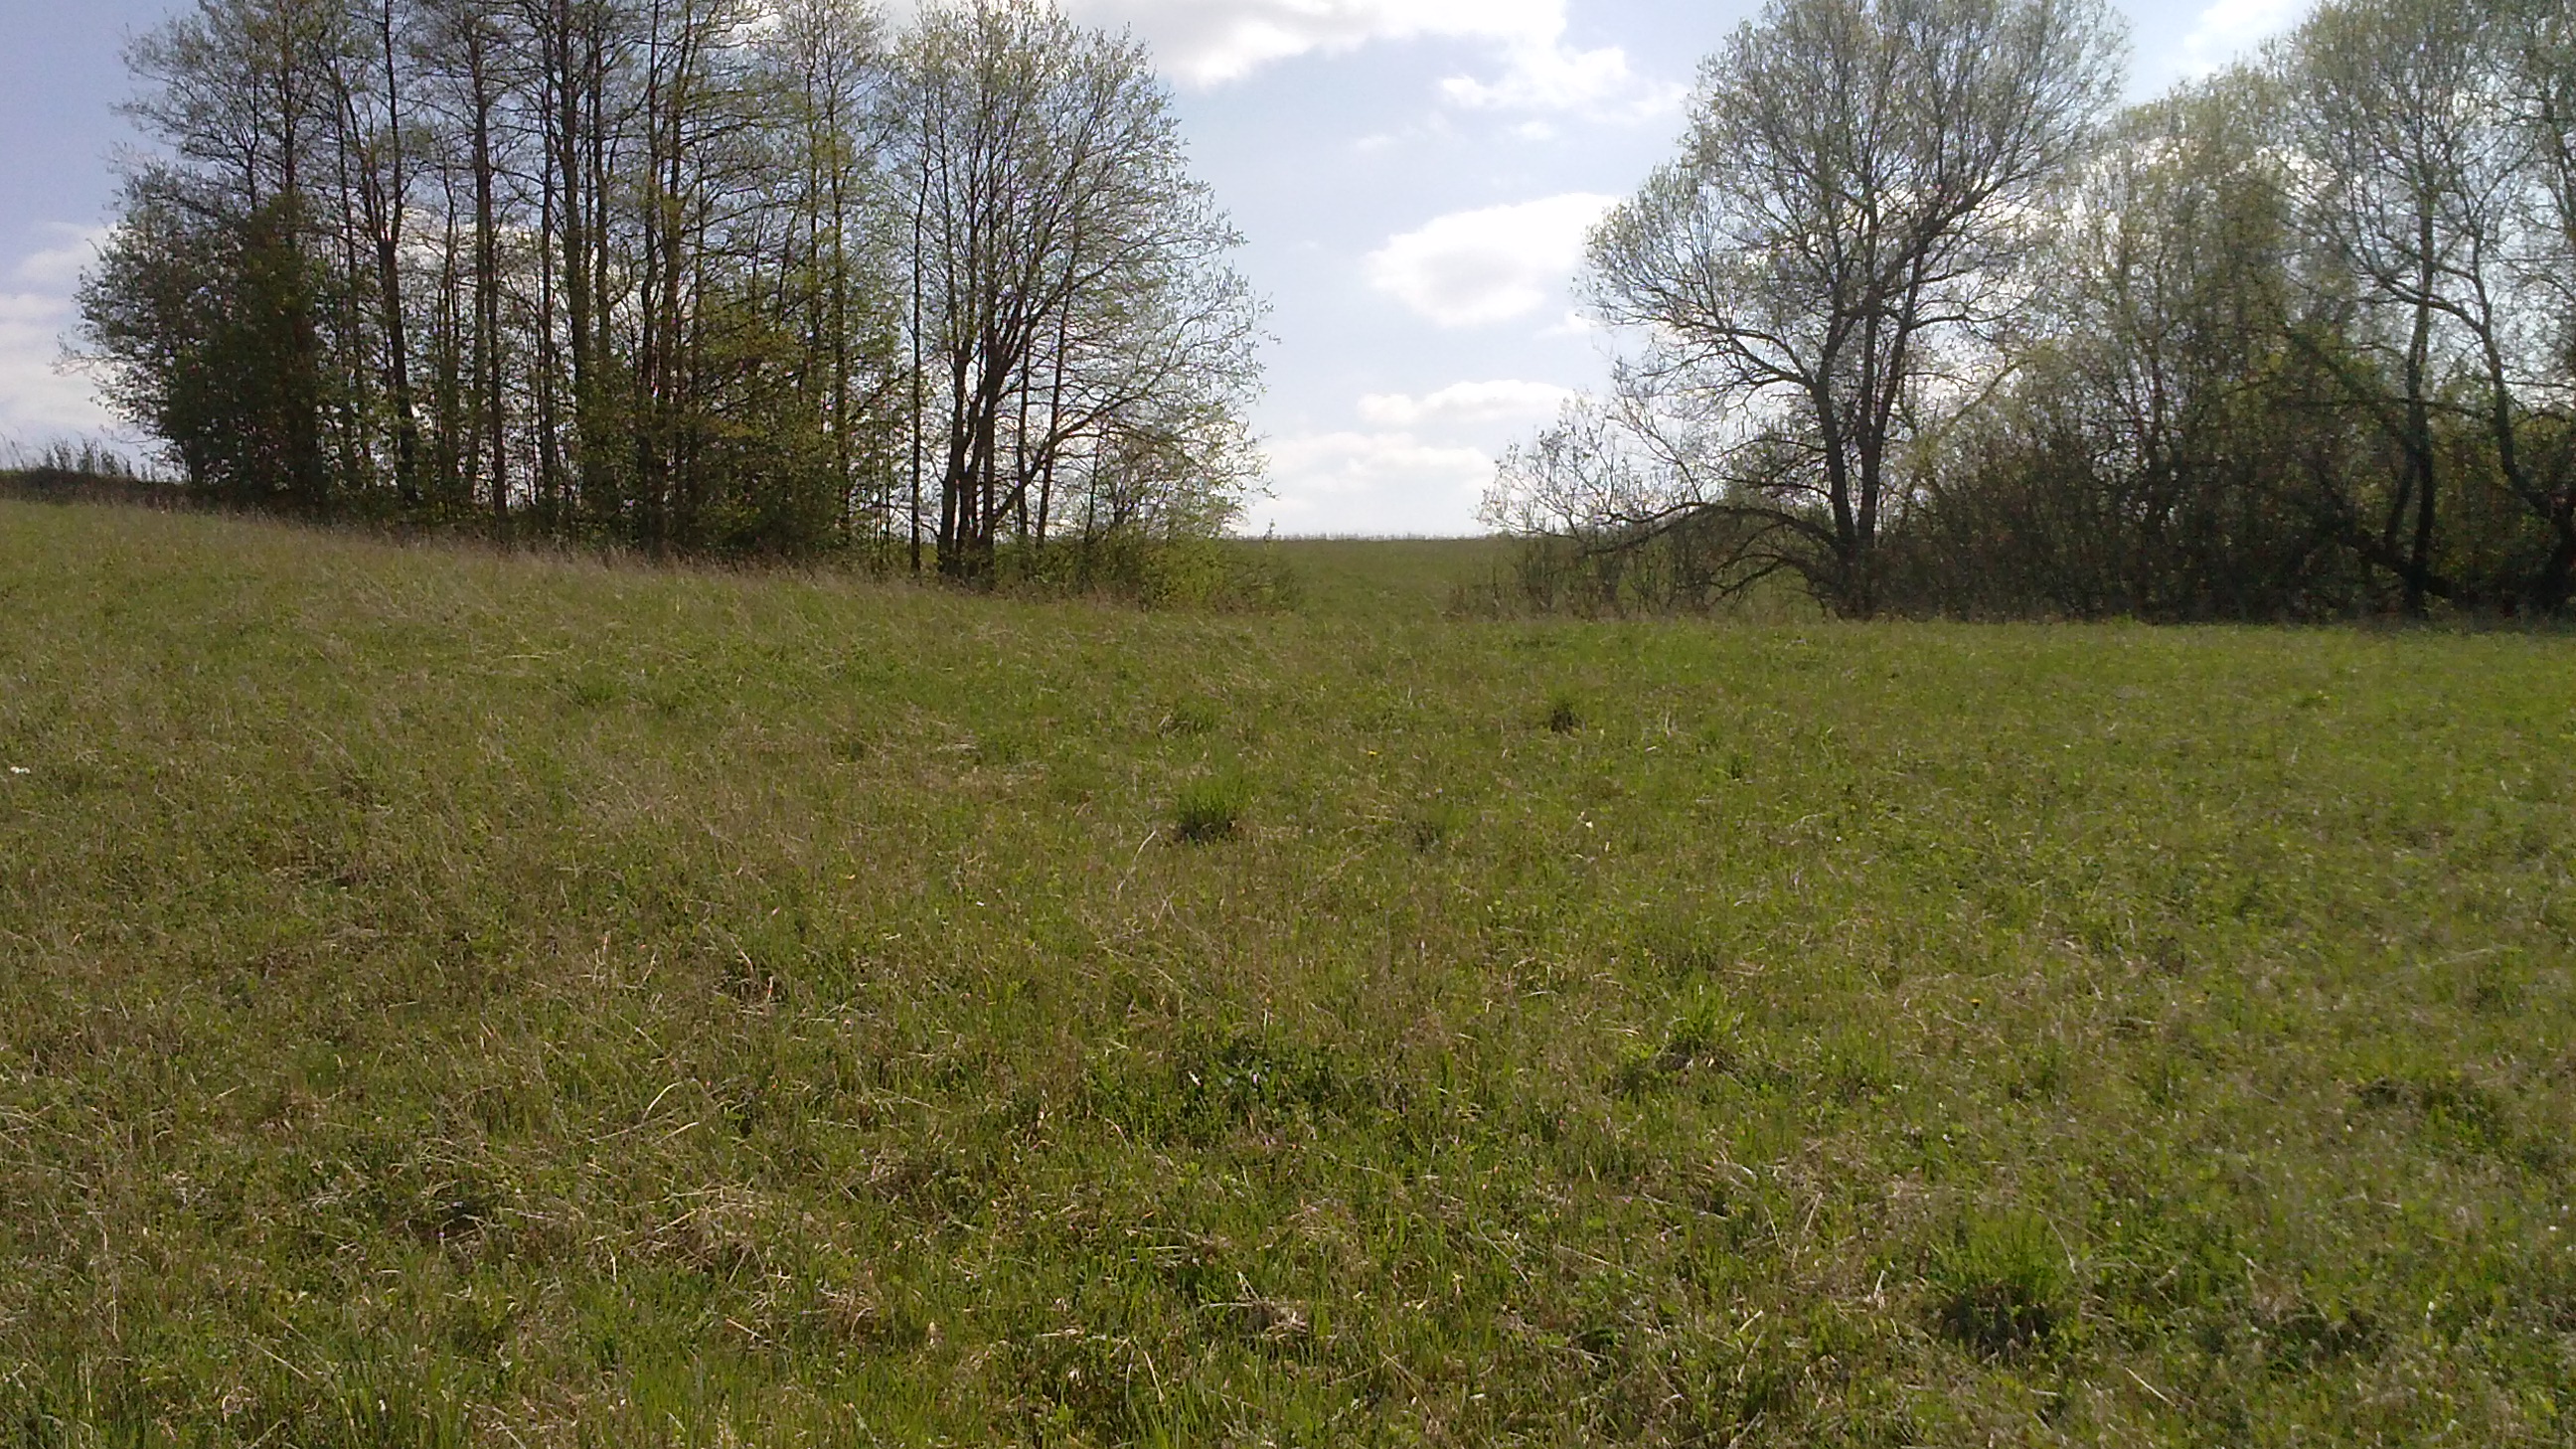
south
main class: Grassland
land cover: Grassland without tree/shrub cover
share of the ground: > 75 %
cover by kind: herbaceous plants 100 %
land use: Agriculture (excluding fallow land and kitchen gardens)
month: May
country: LV
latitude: 55.9800
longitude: 27.4070
